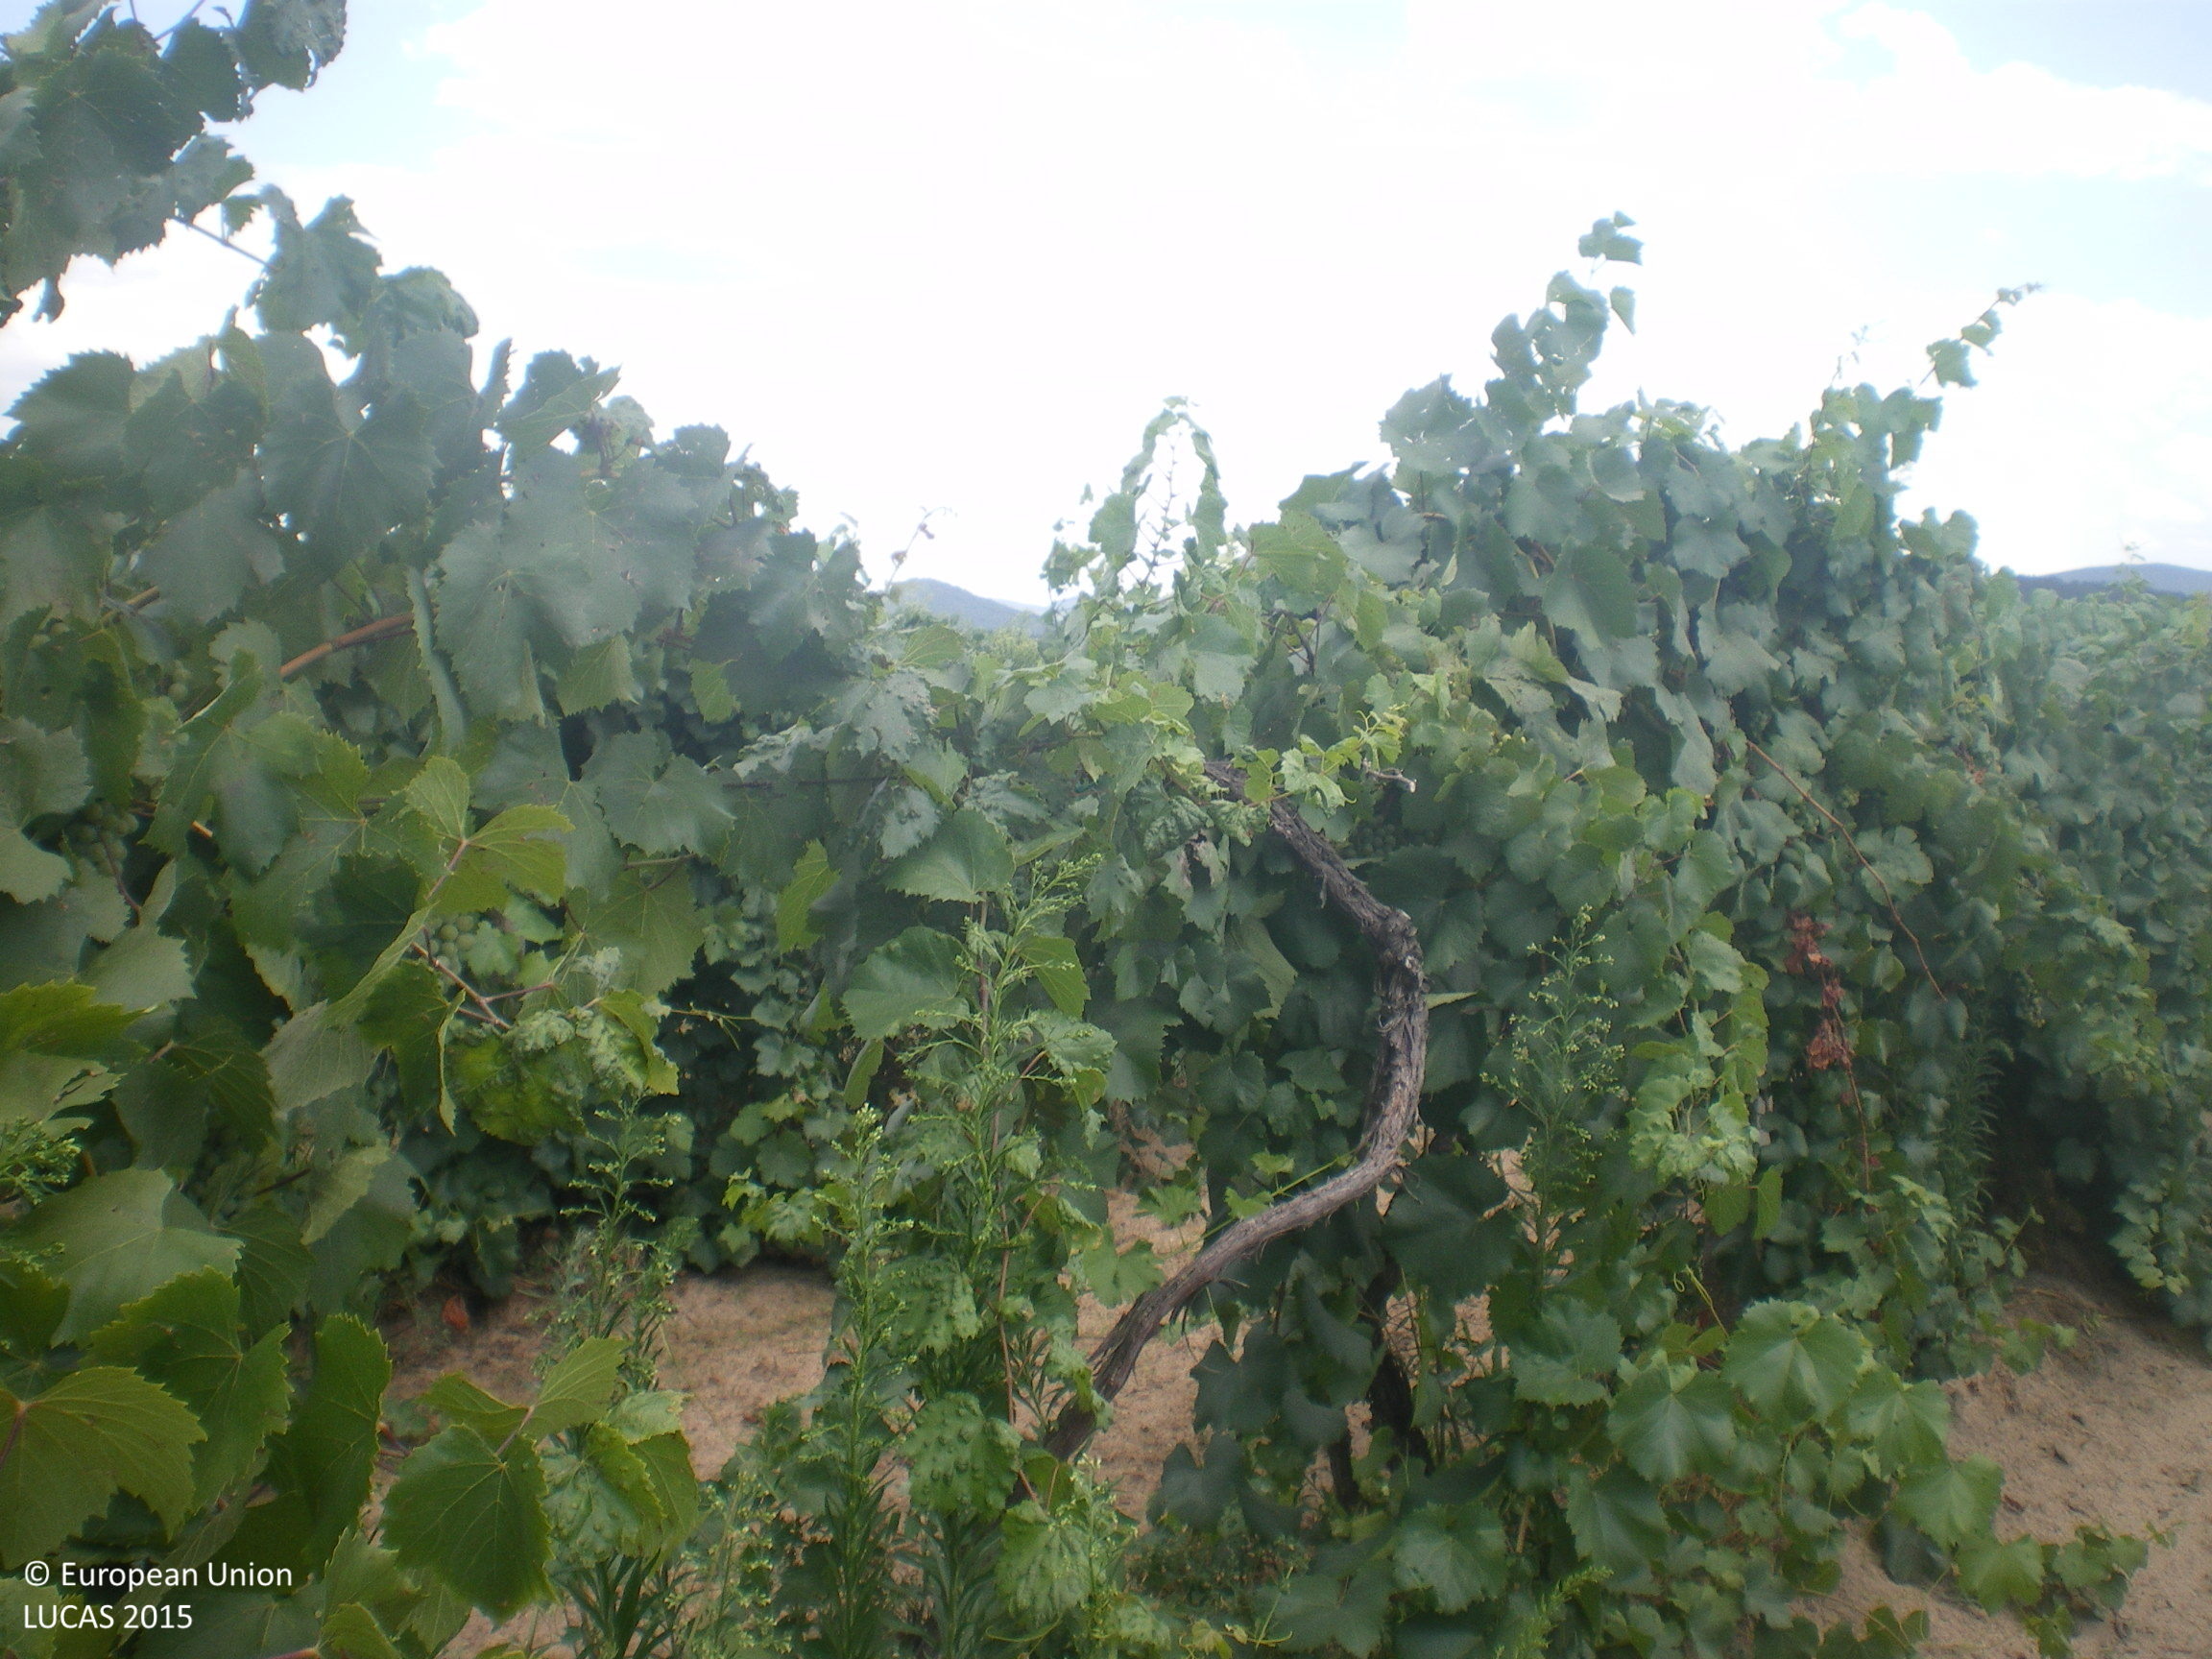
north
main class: Cropland
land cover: Vineyards
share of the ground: 50 - 75 %
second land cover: Other bare soil
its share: > 75 %
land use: Agriculture (excluding fallow land and kitchen gardens)
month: August
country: BG
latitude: 42.6105
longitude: 25.8404
